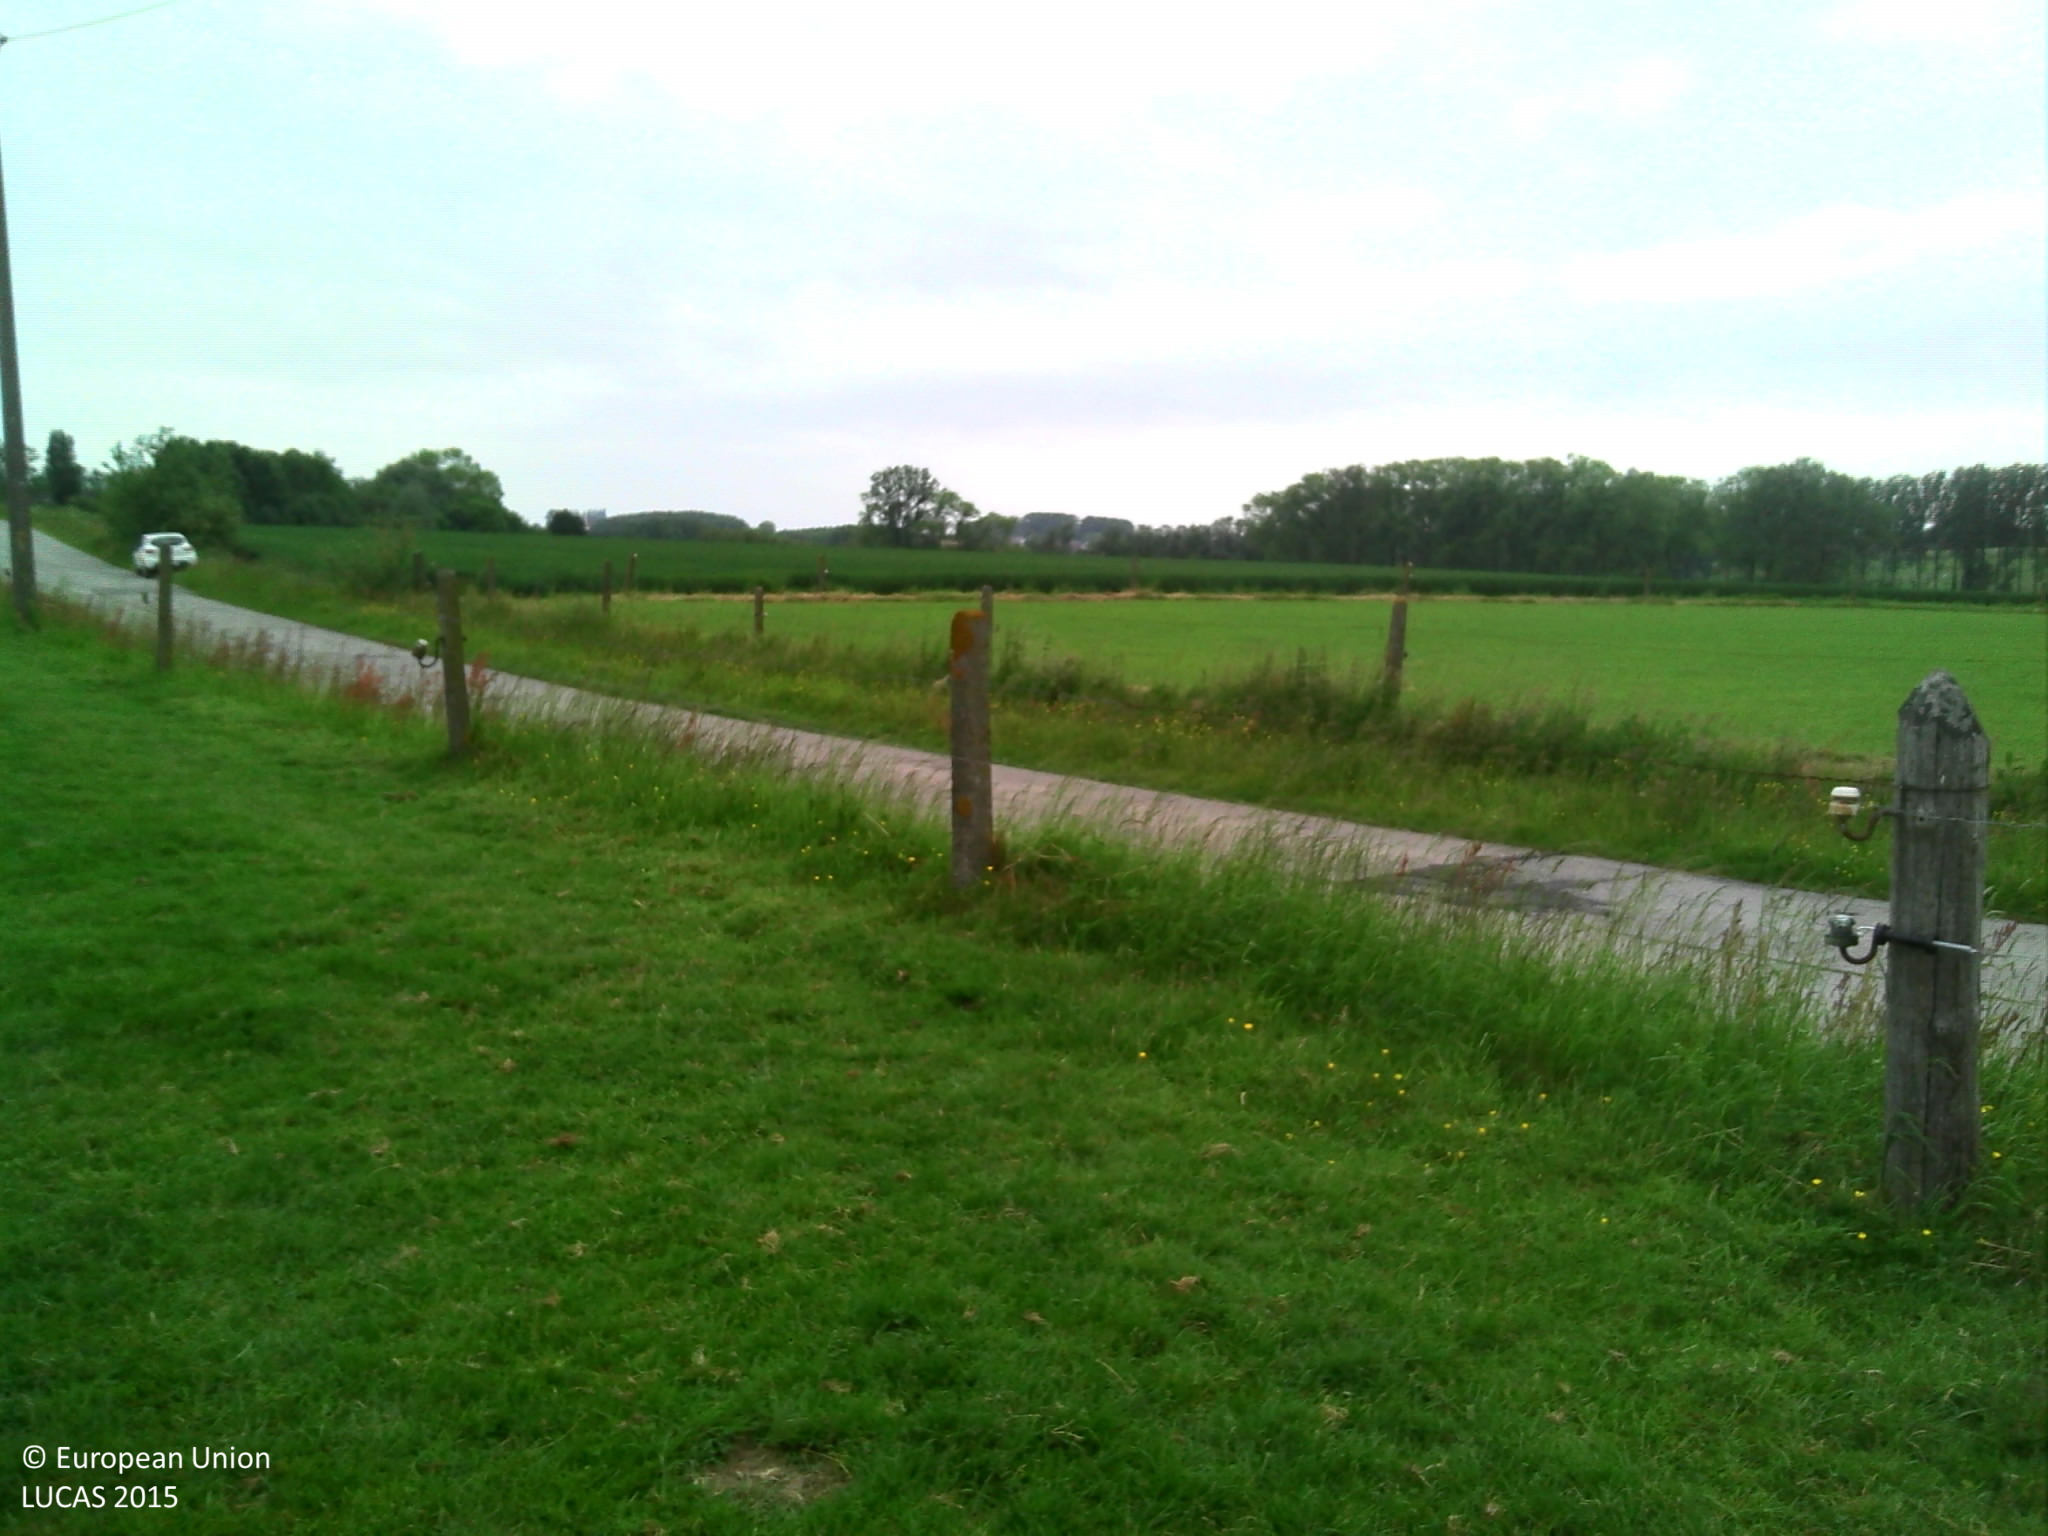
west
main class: Grassland
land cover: Grassland without tree/shrub cover
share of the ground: > 75 %
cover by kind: herbaceous plants 100 %
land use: Agriculture (excluding fallow land and kitchen gardens)
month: June
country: BE
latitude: 50.8623
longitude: 3.7846
